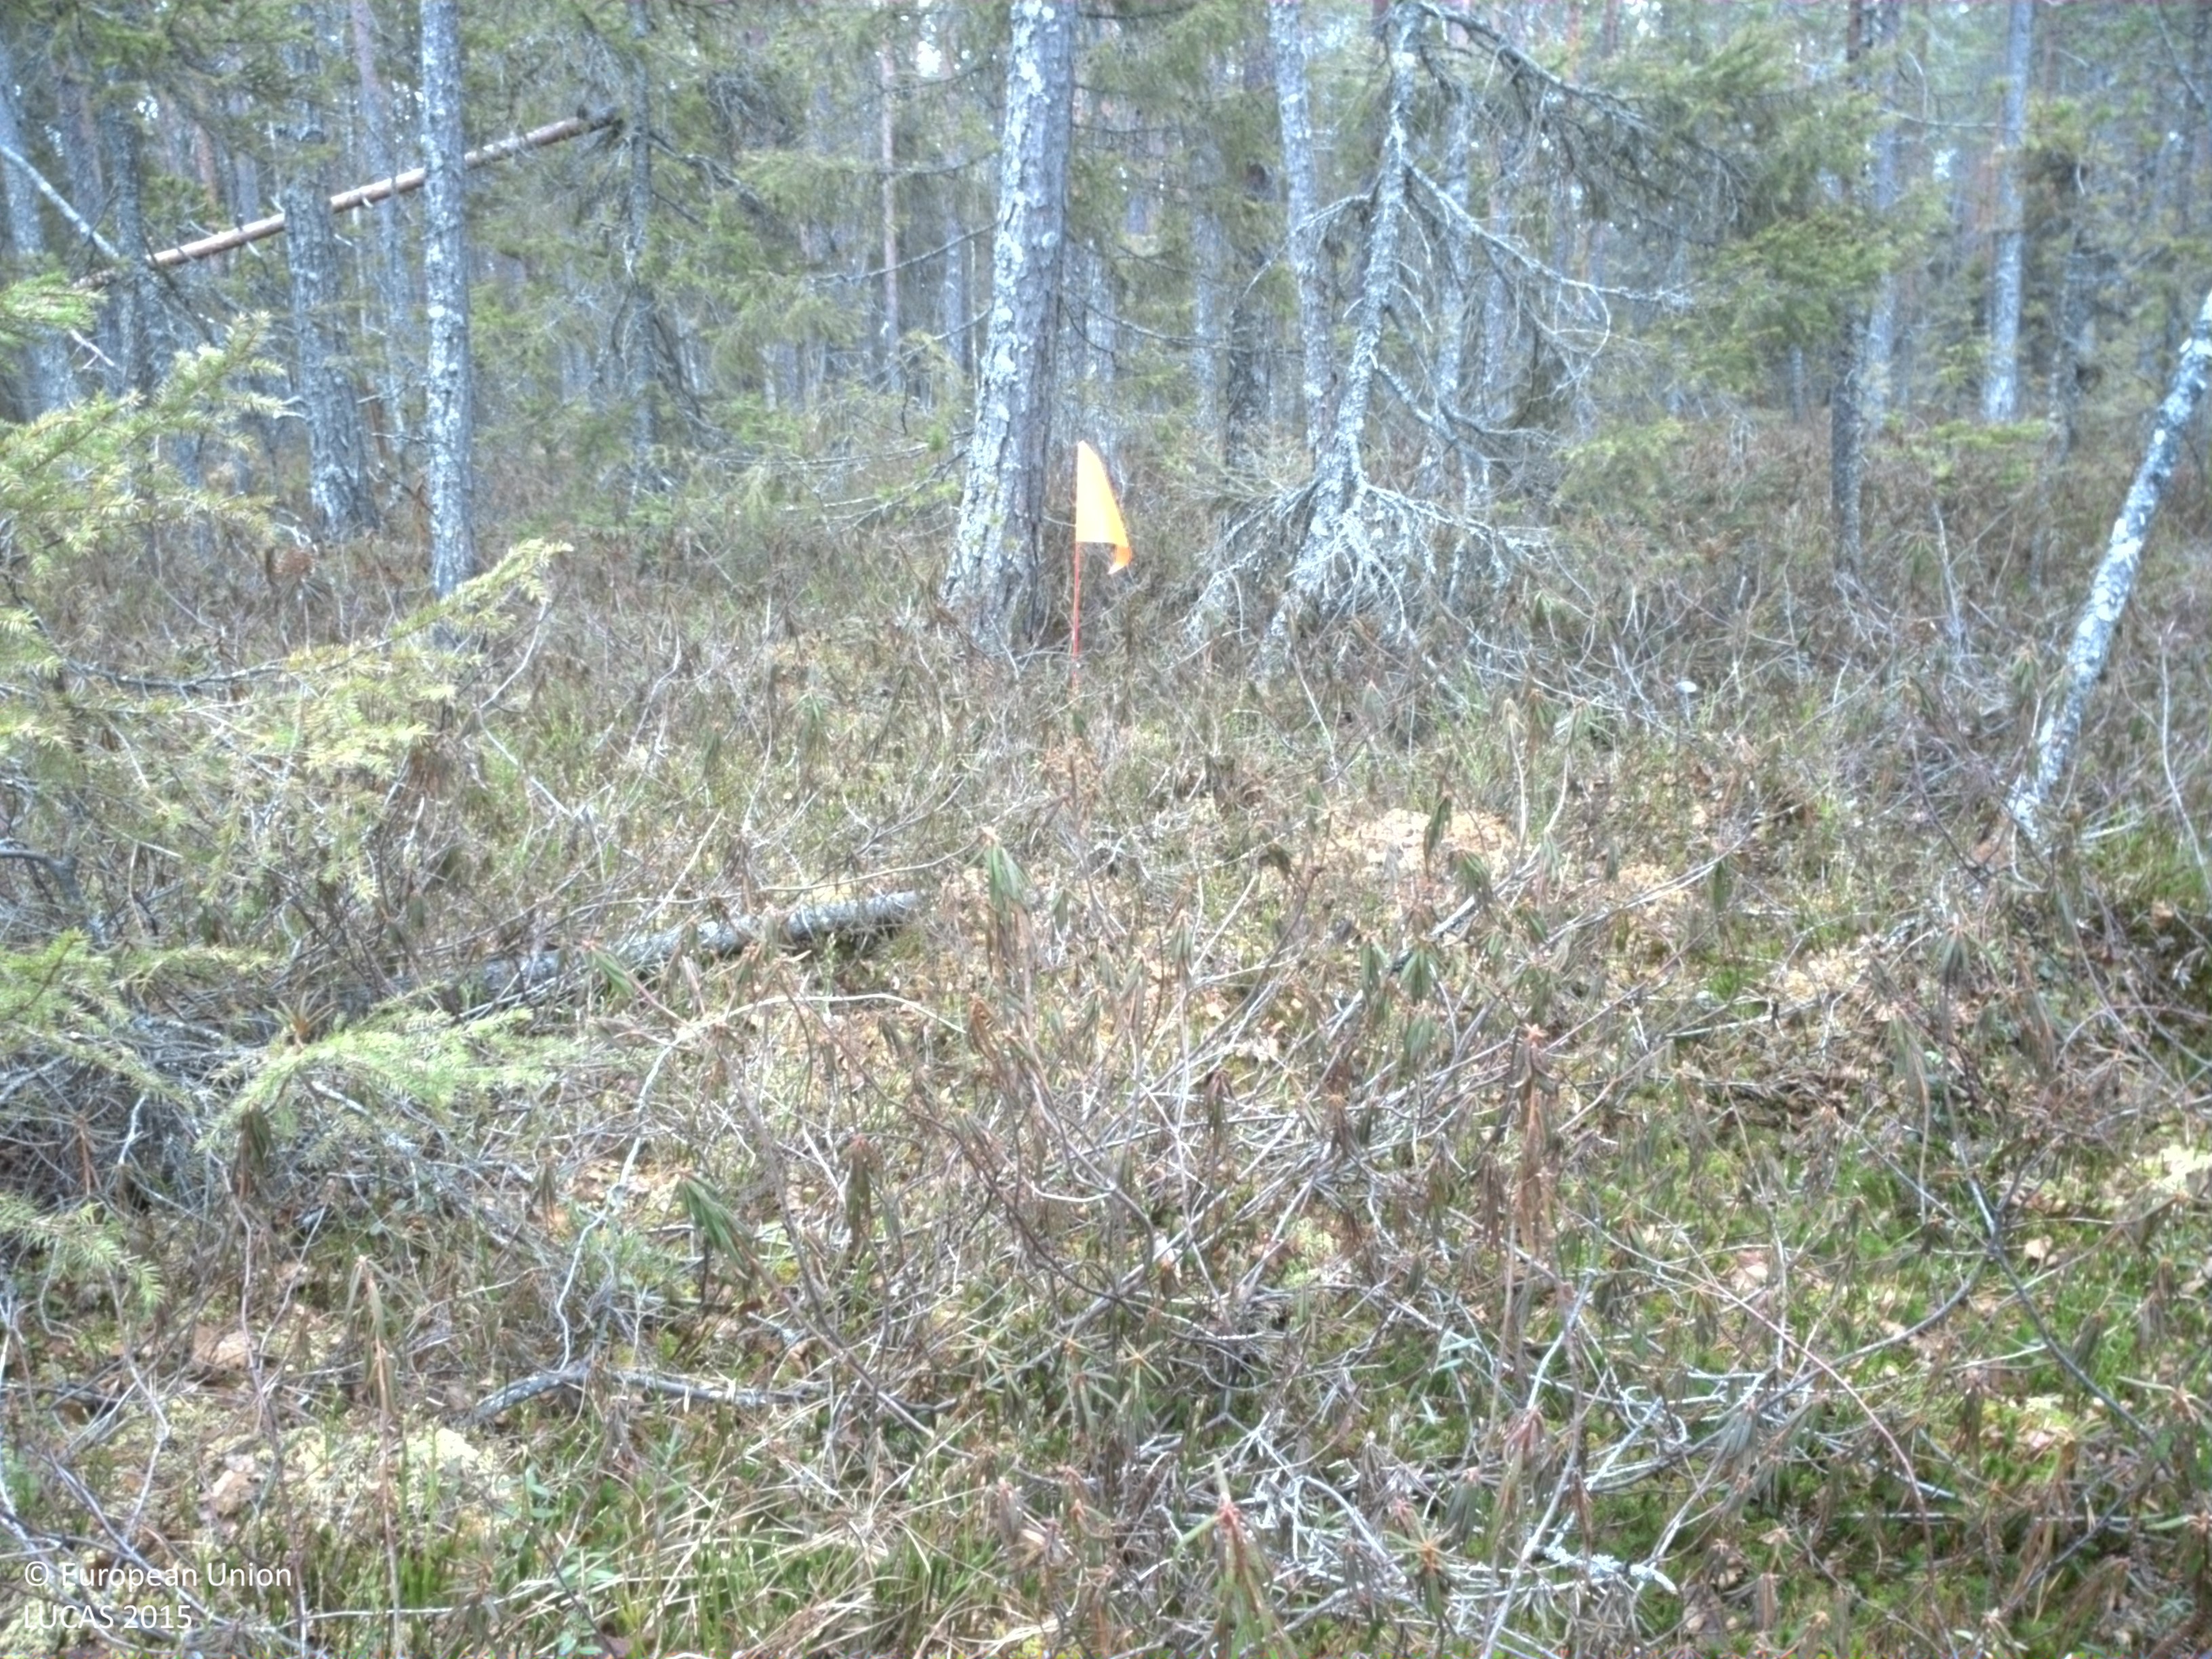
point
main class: Woodland
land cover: Pine dominated coniferous woodland
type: boreal forest
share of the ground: 50 - 75 %
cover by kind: coniferous forest trees 60 %, shrubs 40 %
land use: Forestry
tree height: > 5 m
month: May
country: SE
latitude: 65.8536
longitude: 22.8884
